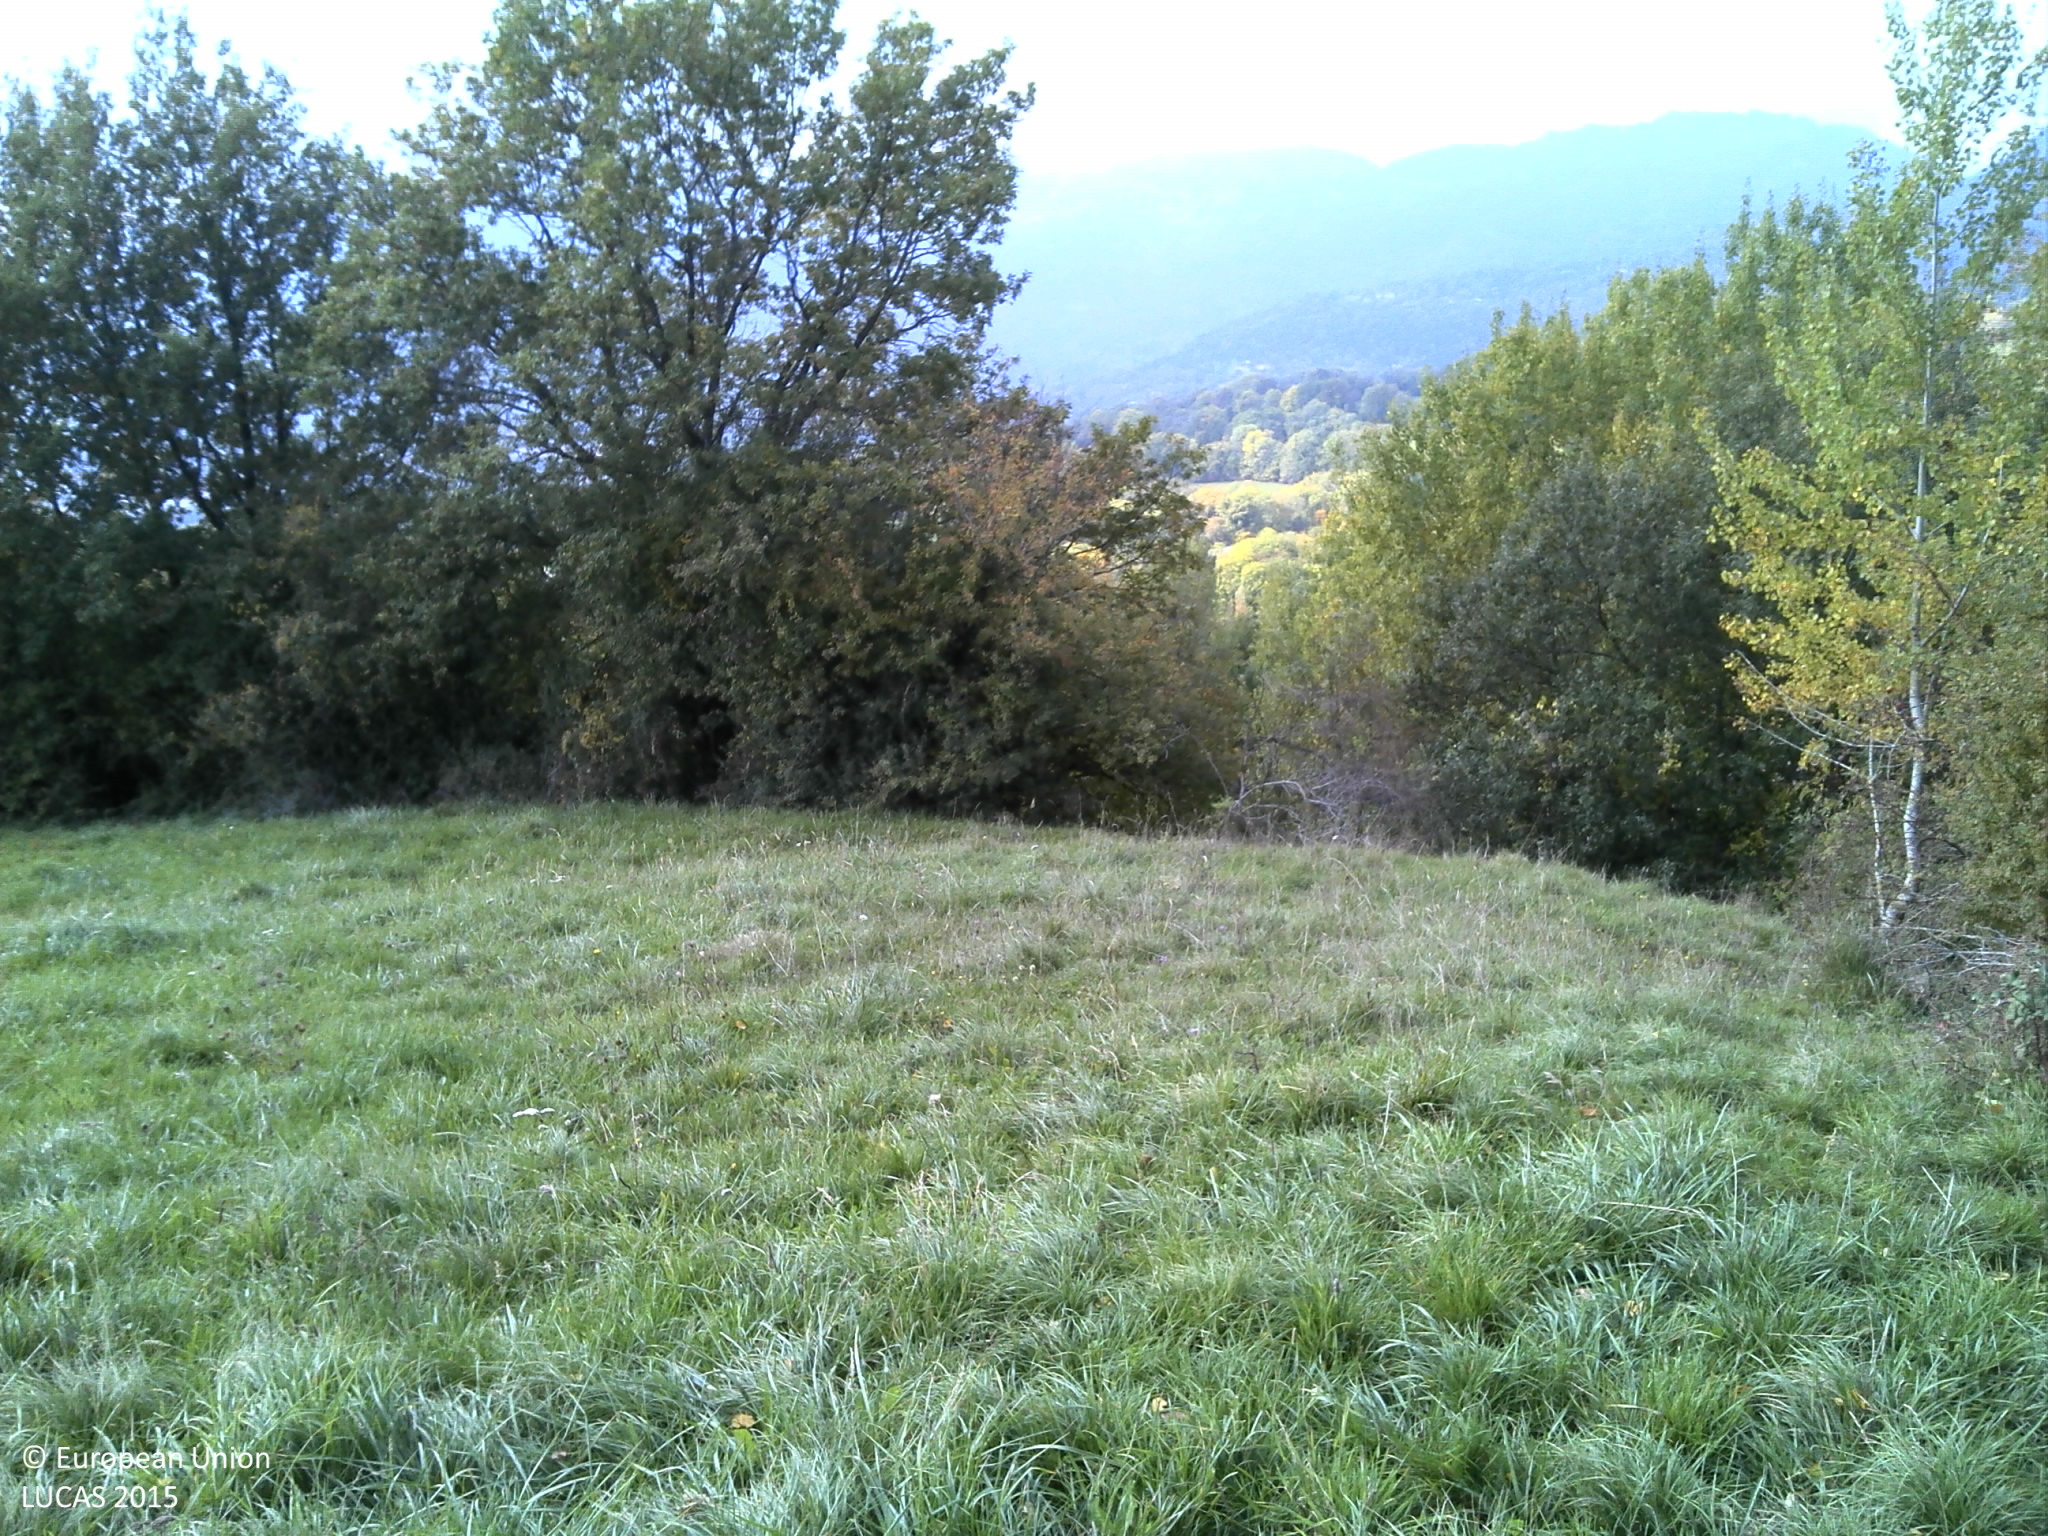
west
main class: Grassland
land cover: Grassland without tree/shrub cover
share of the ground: > 75 %
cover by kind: herbaceous plants 100 %
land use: Agriculture (excluding fallow land and kitchen gardens)
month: October
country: FR
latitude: 46.3520
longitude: 6.0917
